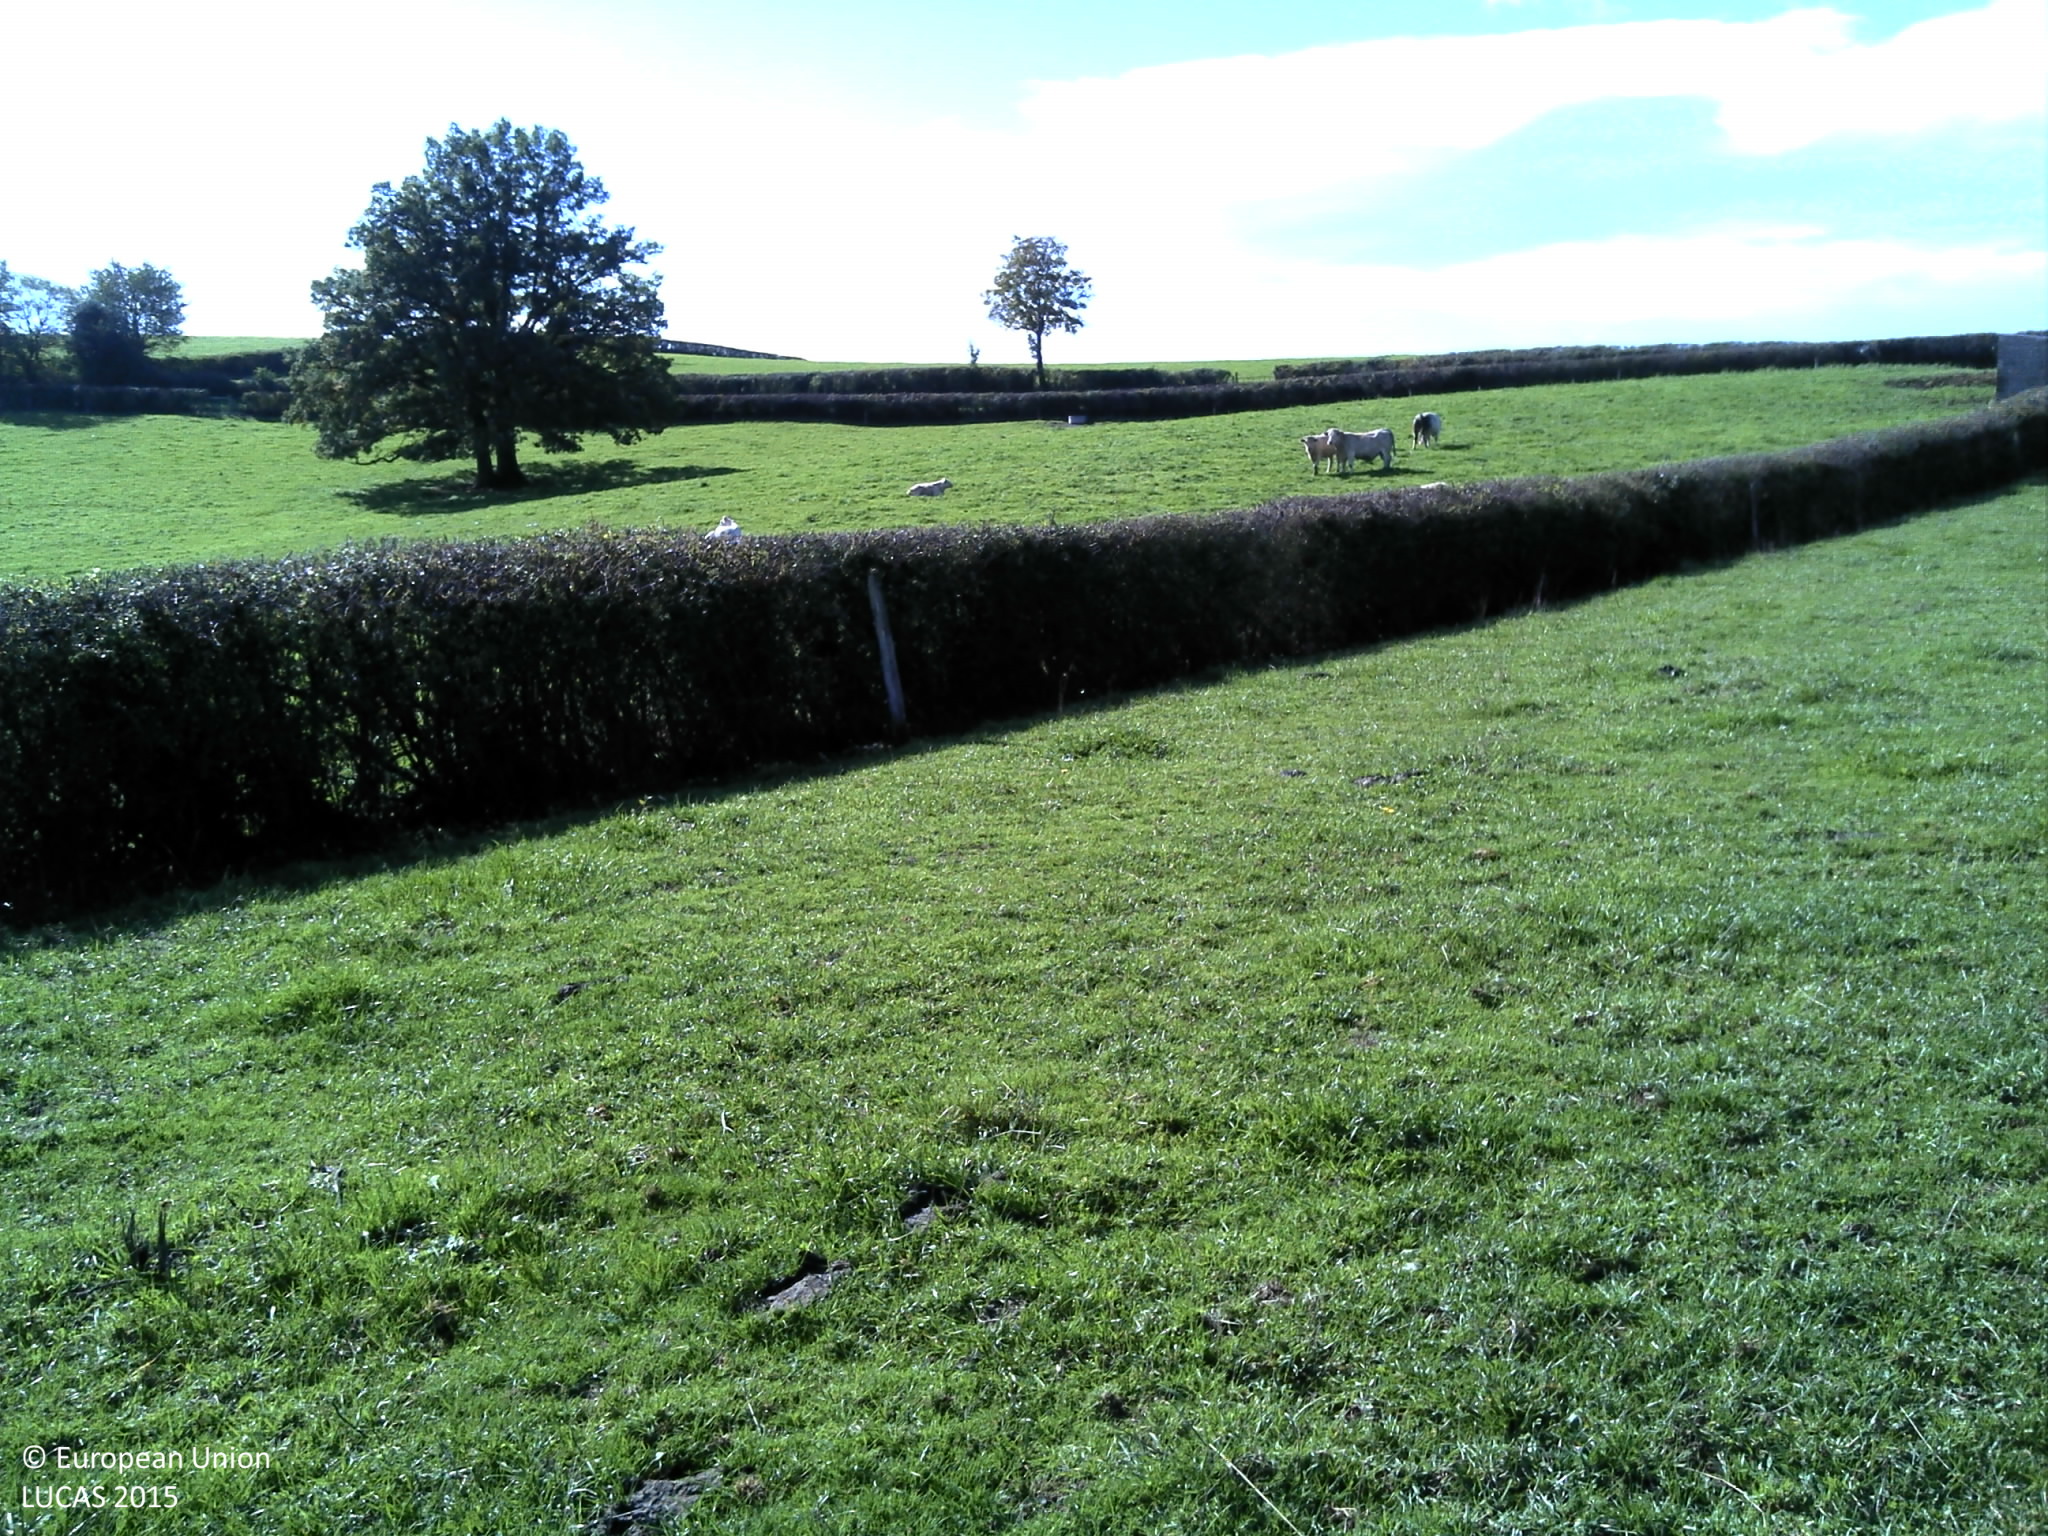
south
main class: Grassland
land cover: Grassland without tree/shrub cover
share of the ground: > 75 %
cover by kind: herbaceous plants 100 %
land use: Agriculture (excluding fallow land and kitchen gardens)
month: October
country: FR
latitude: 46.6553
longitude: 4.0543
